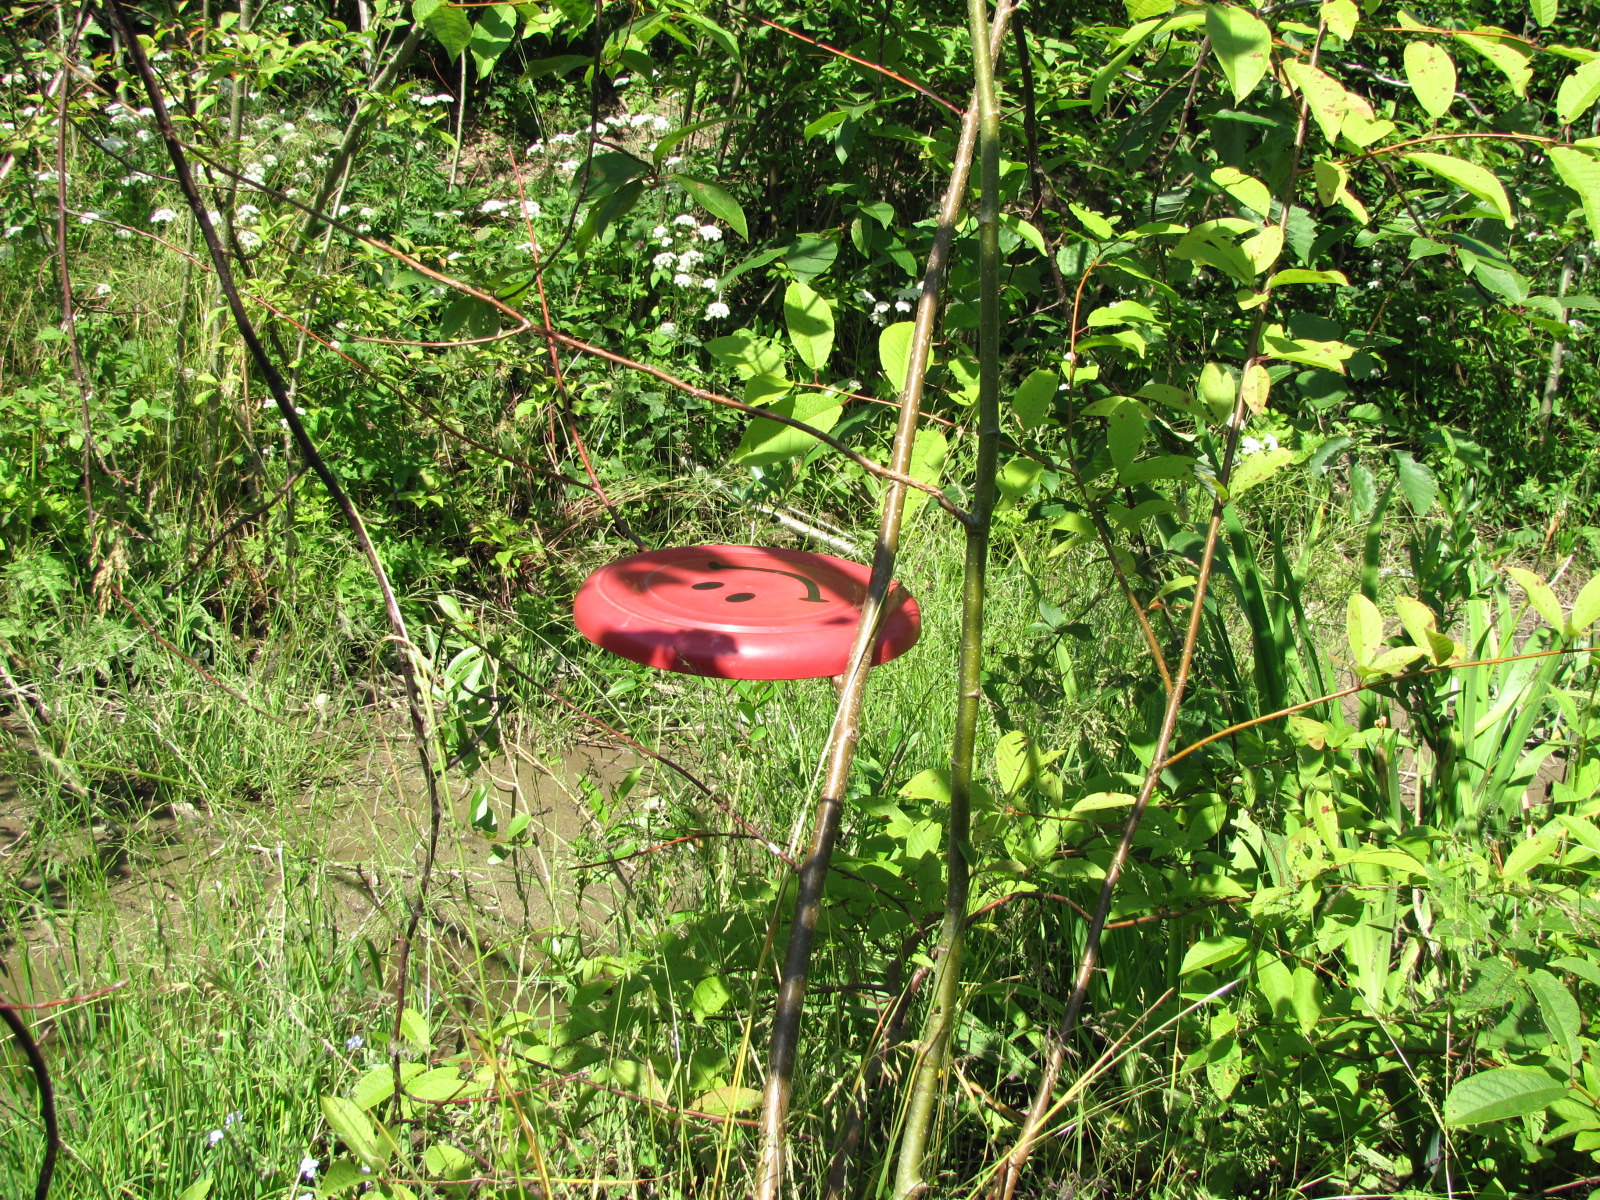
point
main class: Woodland
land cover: Broadleaved woodland
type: non-riverine alder, birch or aspen forest
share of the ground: > 75 %
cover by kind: broadleaved forest trees 100 %
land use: Forestry
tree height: < 5 m
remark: Clear cut
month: June
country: LV
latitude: 56.3595
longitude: 23.8897
